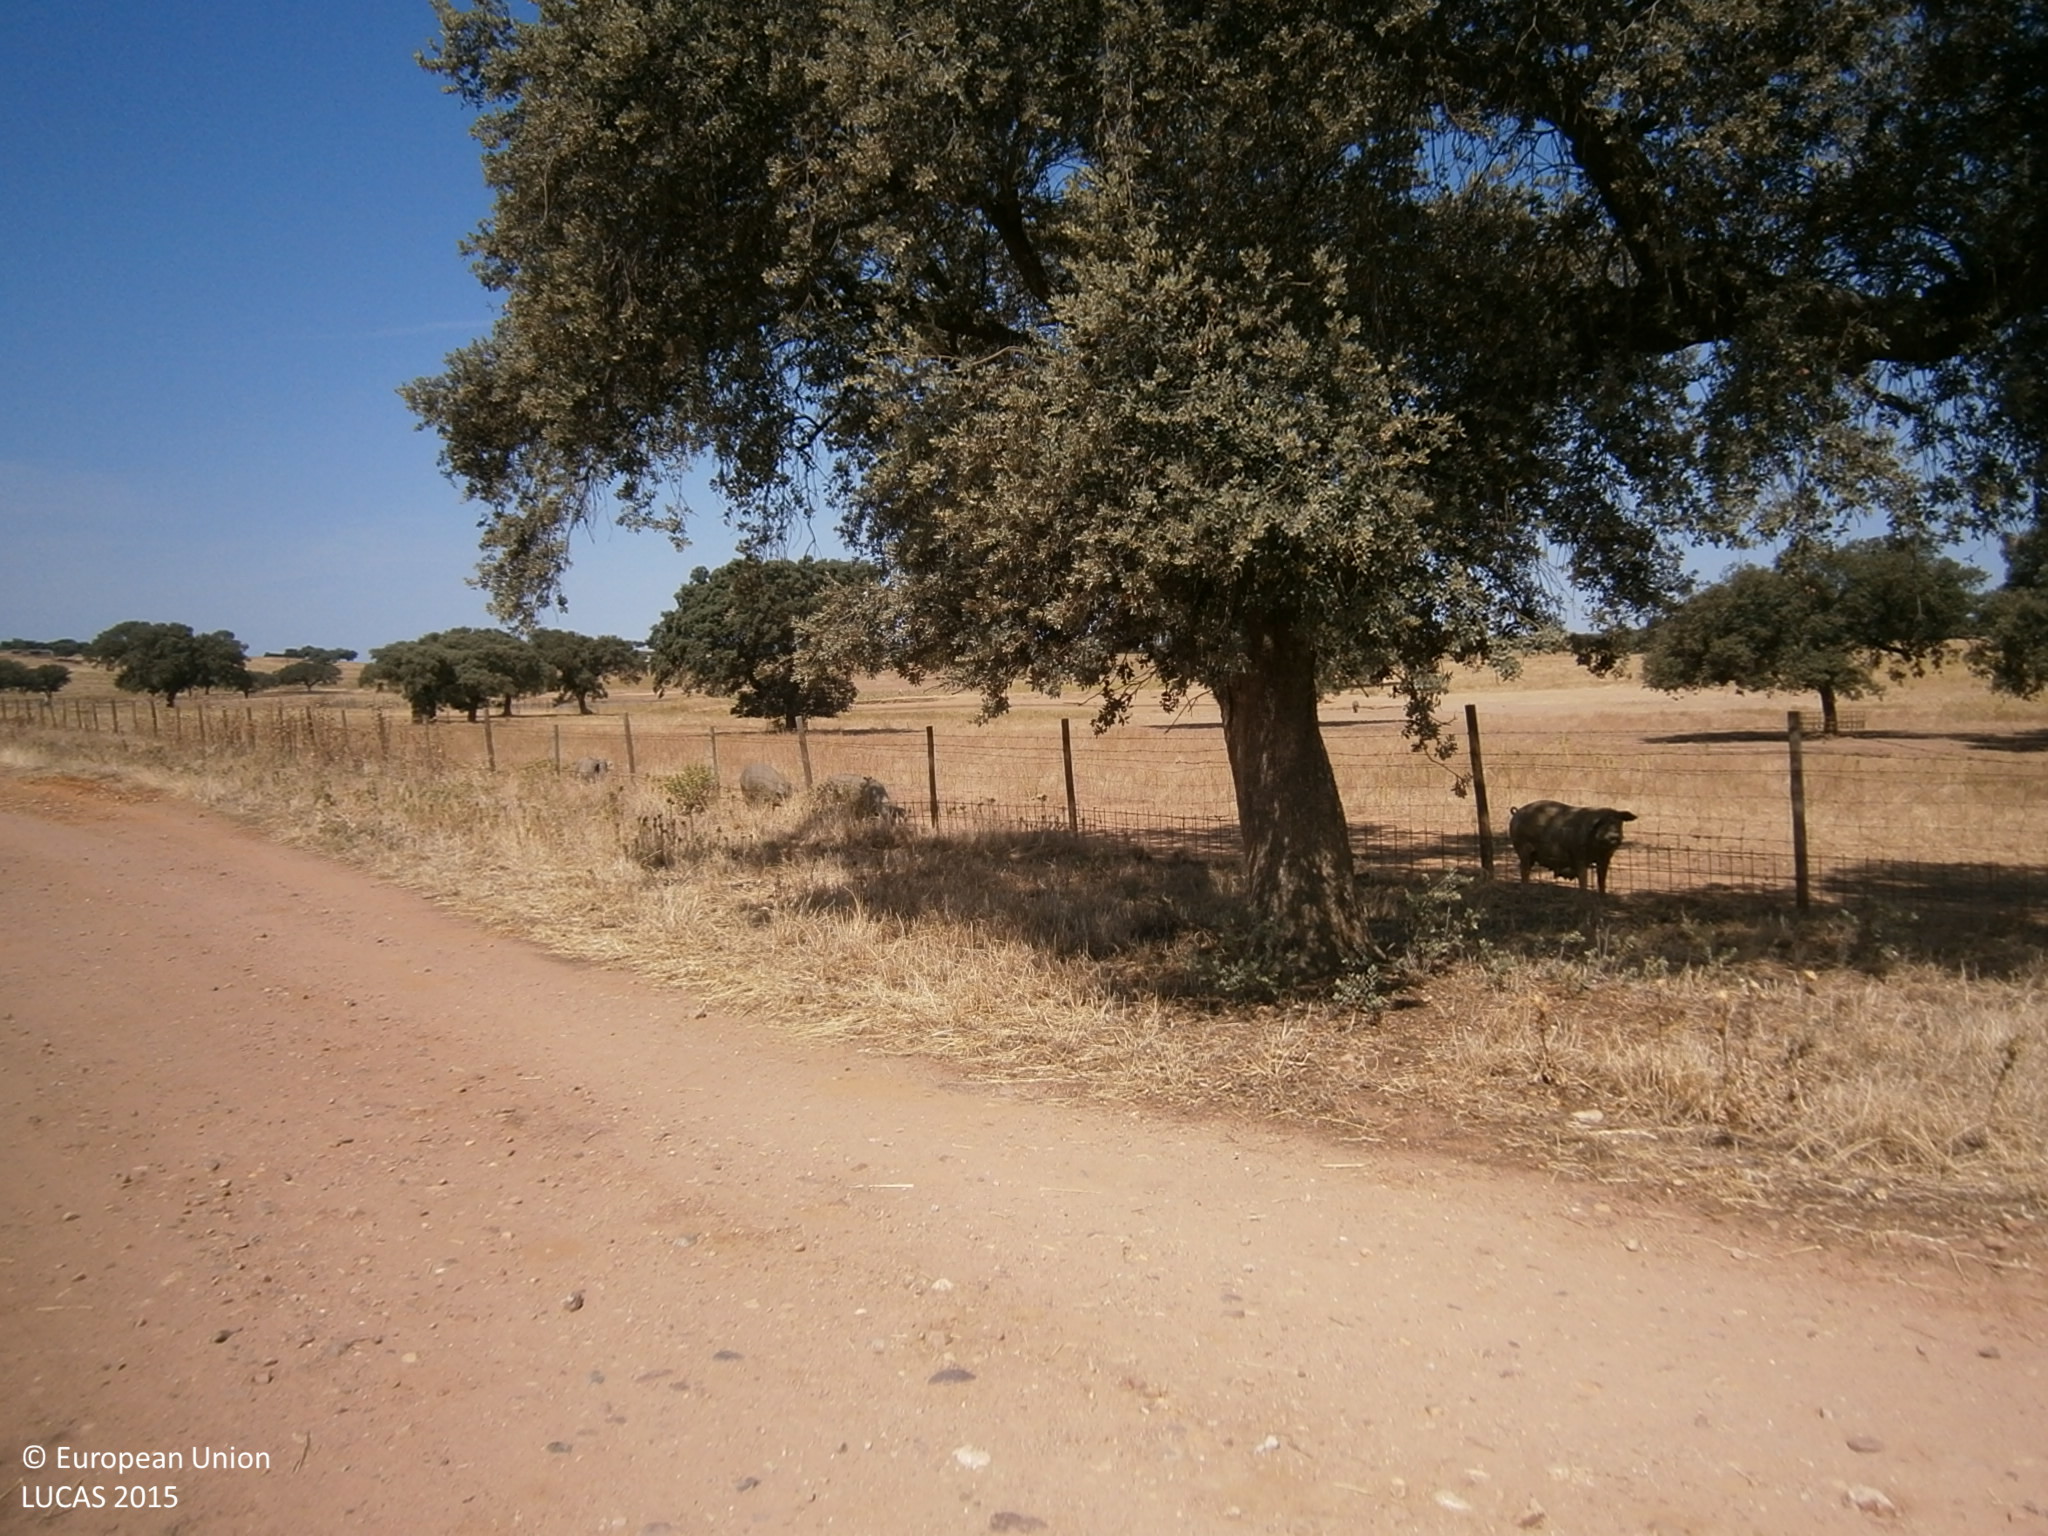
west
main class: Cropland
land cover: Durum wheat
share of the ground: > 75 %
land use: Agriculture (excluding fallow land and kitchen gardens)
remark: Harvested field
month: July
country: ES
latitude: 39.0094
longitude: -6.8020
